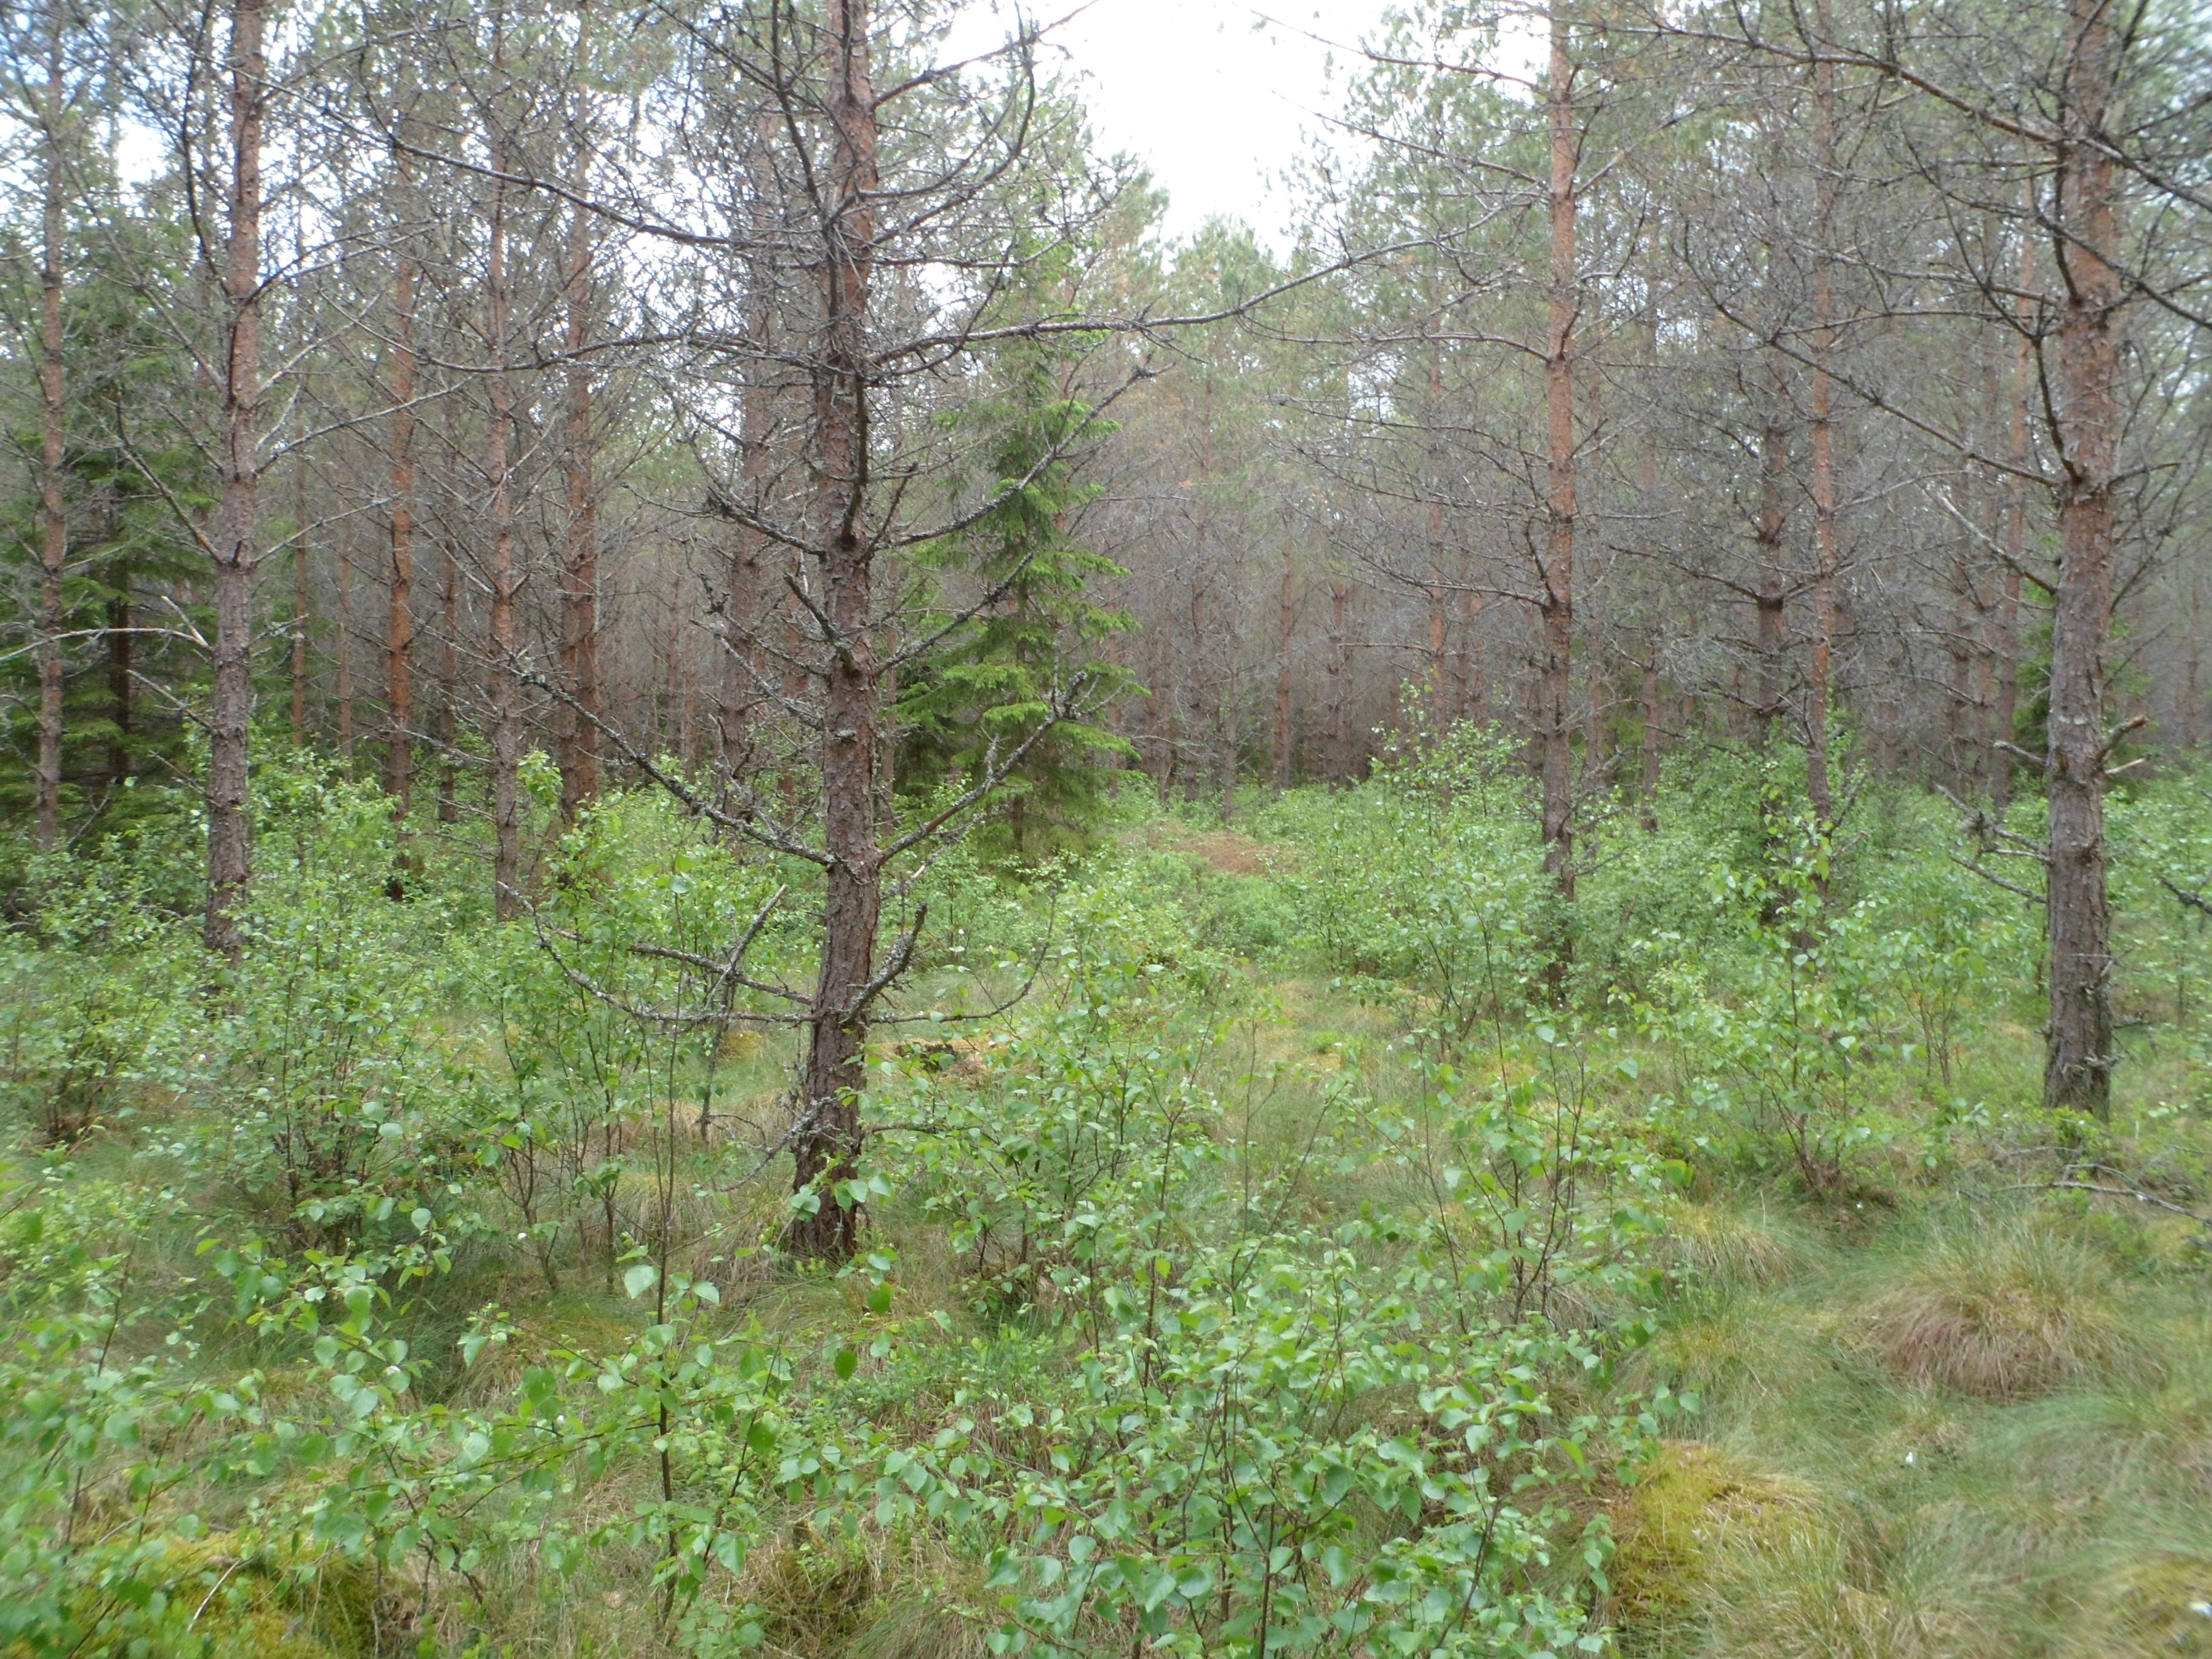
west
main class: Woodland
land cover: Pine dominated coniferous woodland
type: boreal forest
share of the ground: 50 - 75 %
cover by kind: coniferous forest trees 55 %, herbaceous plants 20 %, broadleaved forest trees 10 %, shrubs 10 %, lichens and mosses 5 %
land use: Forestry
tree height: > 5 m
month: June
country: SE
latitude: 56.9738
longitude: 14.4878
